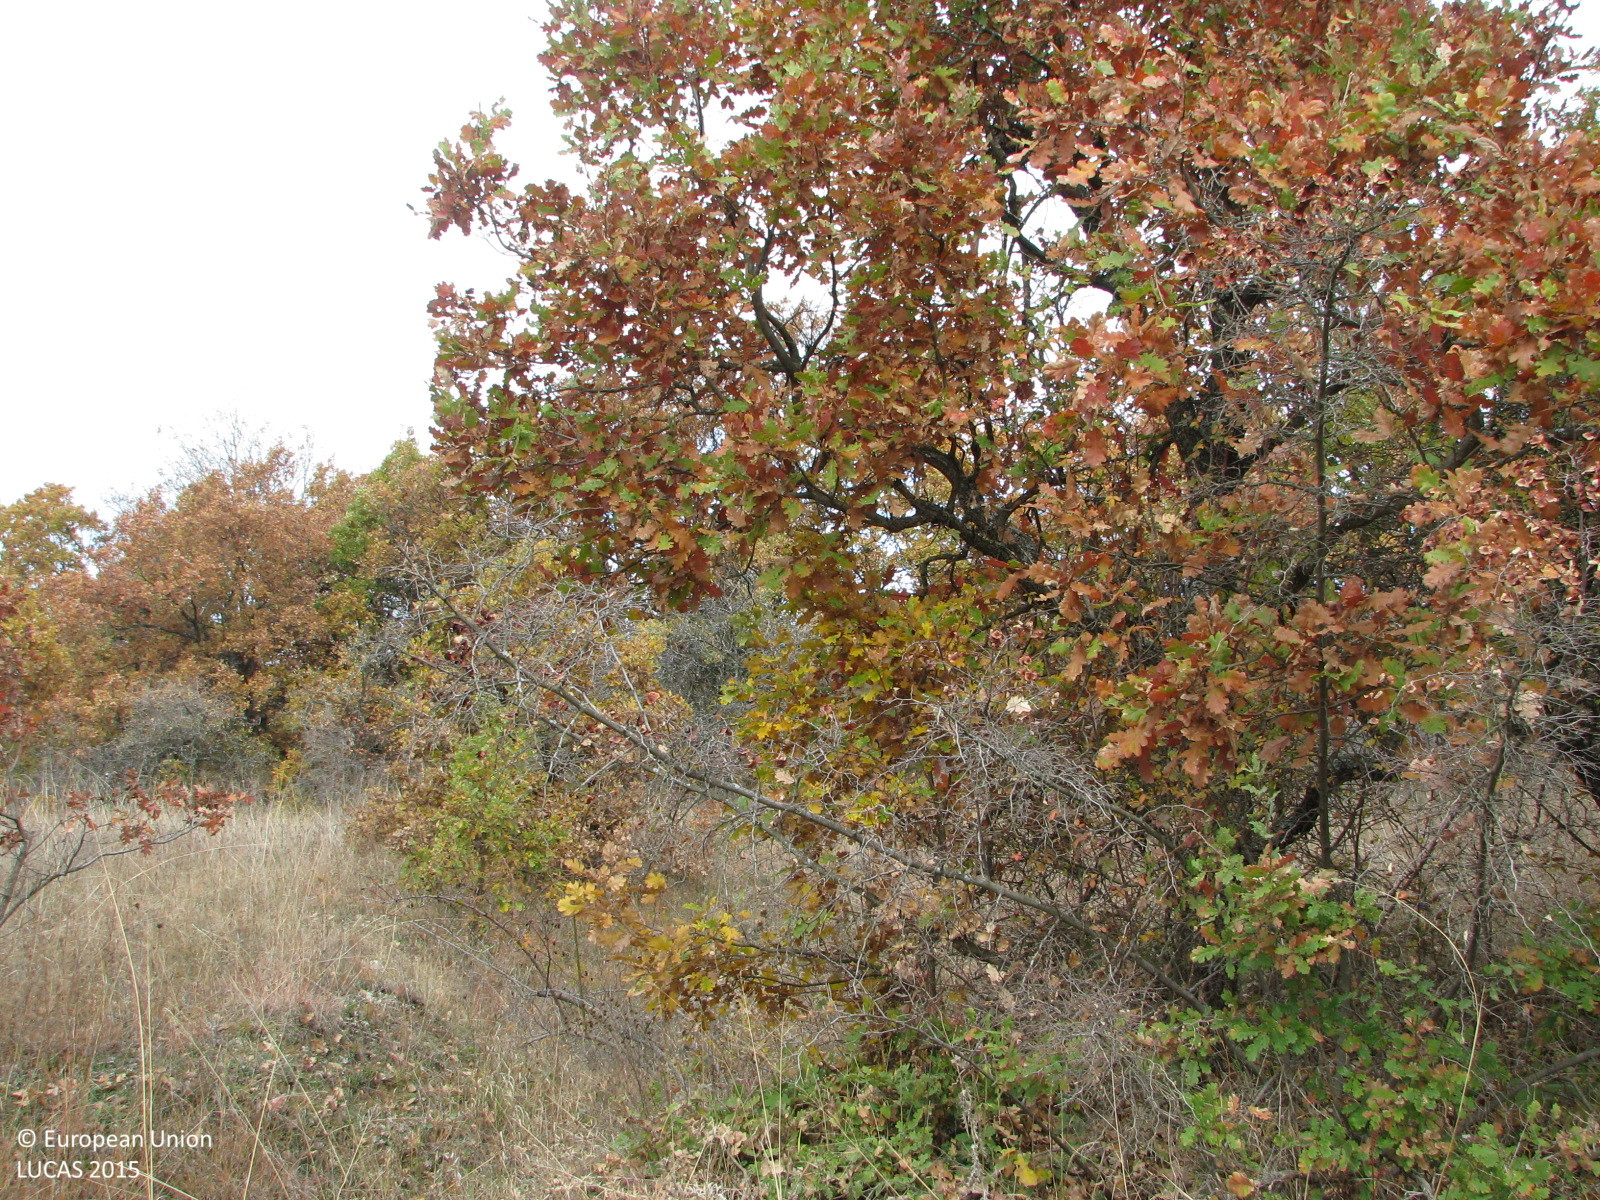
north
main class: Woodland
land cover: Broadleaved woodland
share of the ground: 25 - 50 %
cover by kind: herbaceous plants 50 %, broadleaved forest trees 35 %, shrubs 15 %
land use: Semi-natural and natural areas not in use
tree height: < 5 m
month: November
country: BG
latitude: 41.9046
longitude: 26.3427
